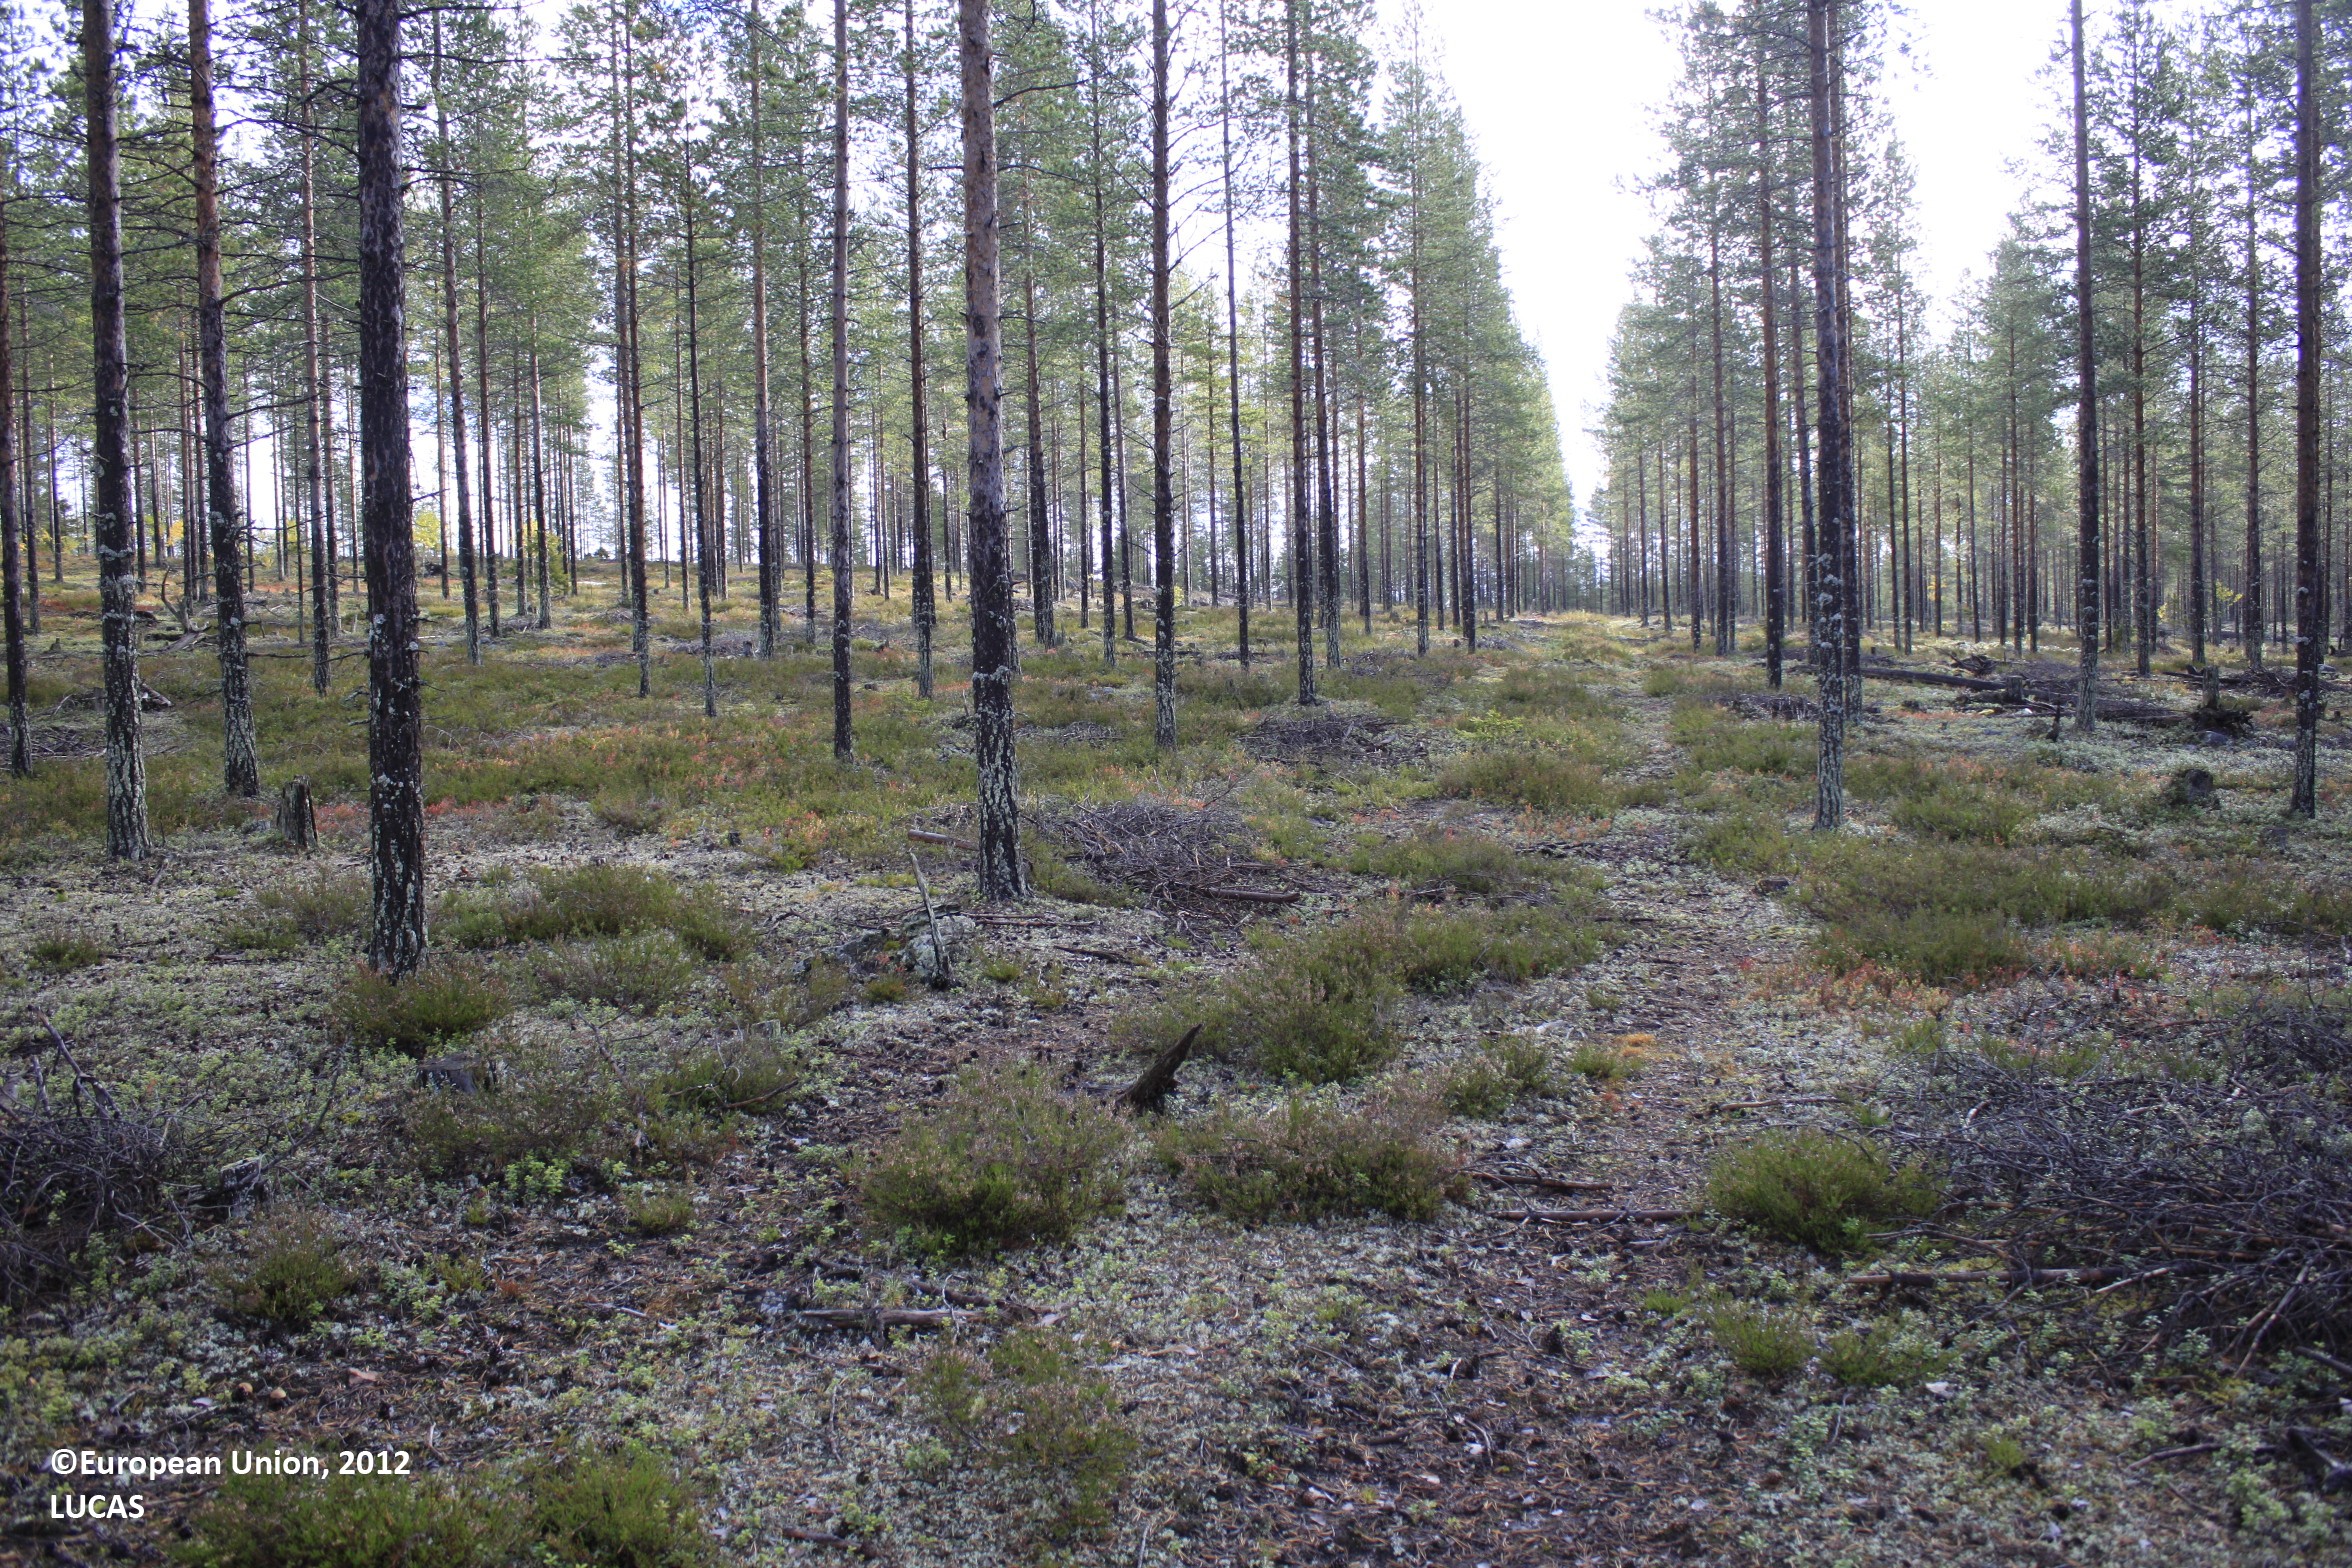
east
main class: Woodland
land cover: Pine dominated coniferous woodland
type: boreal forest
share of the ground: 25 - 50 %
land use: Forestry
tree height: > 5 m
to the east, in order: Pine dominated coniferous woodland; Ditches and canals; Tracks; Ditches and canals; Pine dominated coniferous woodland
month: September
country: FI
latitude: 65.5710
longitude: 27.3516
